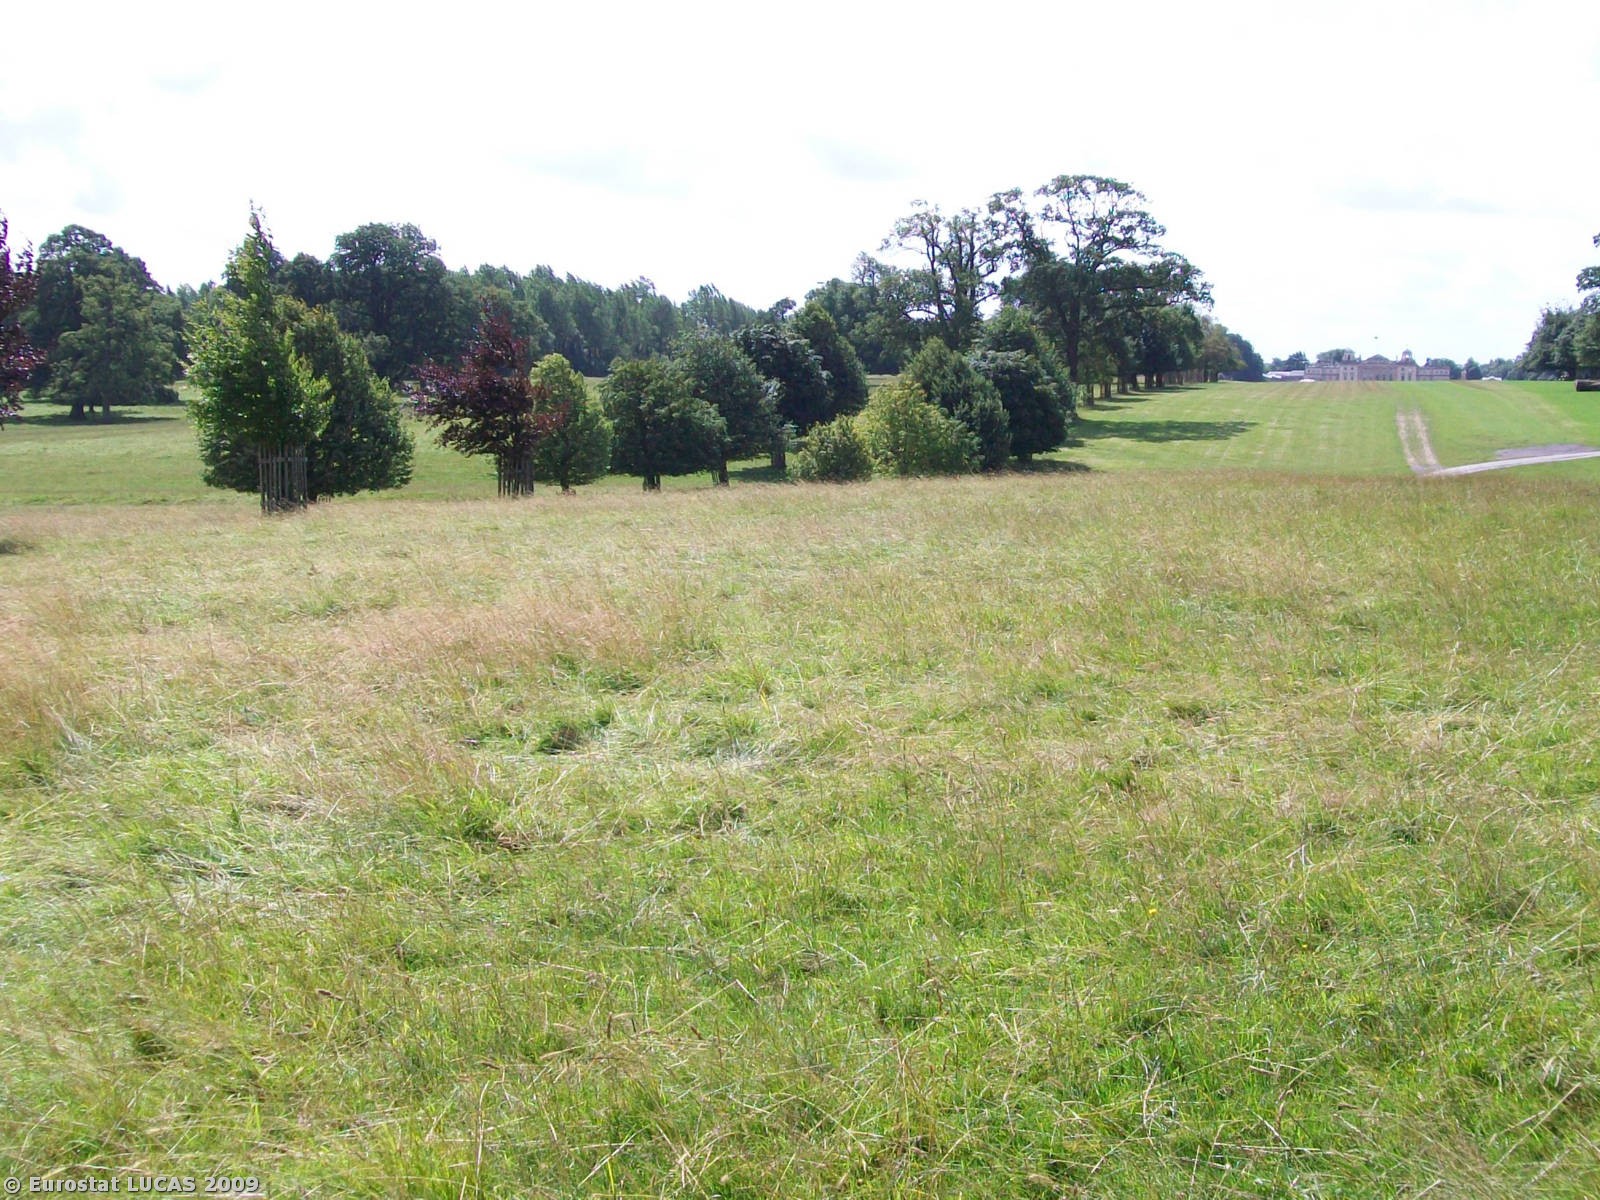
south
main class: Grassland
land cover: Grassland without tree/shrub cover
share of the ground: > 75 %
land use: Amenities, museums, leisure
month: July
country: GB
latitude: 51.5551
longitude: -2.2791
